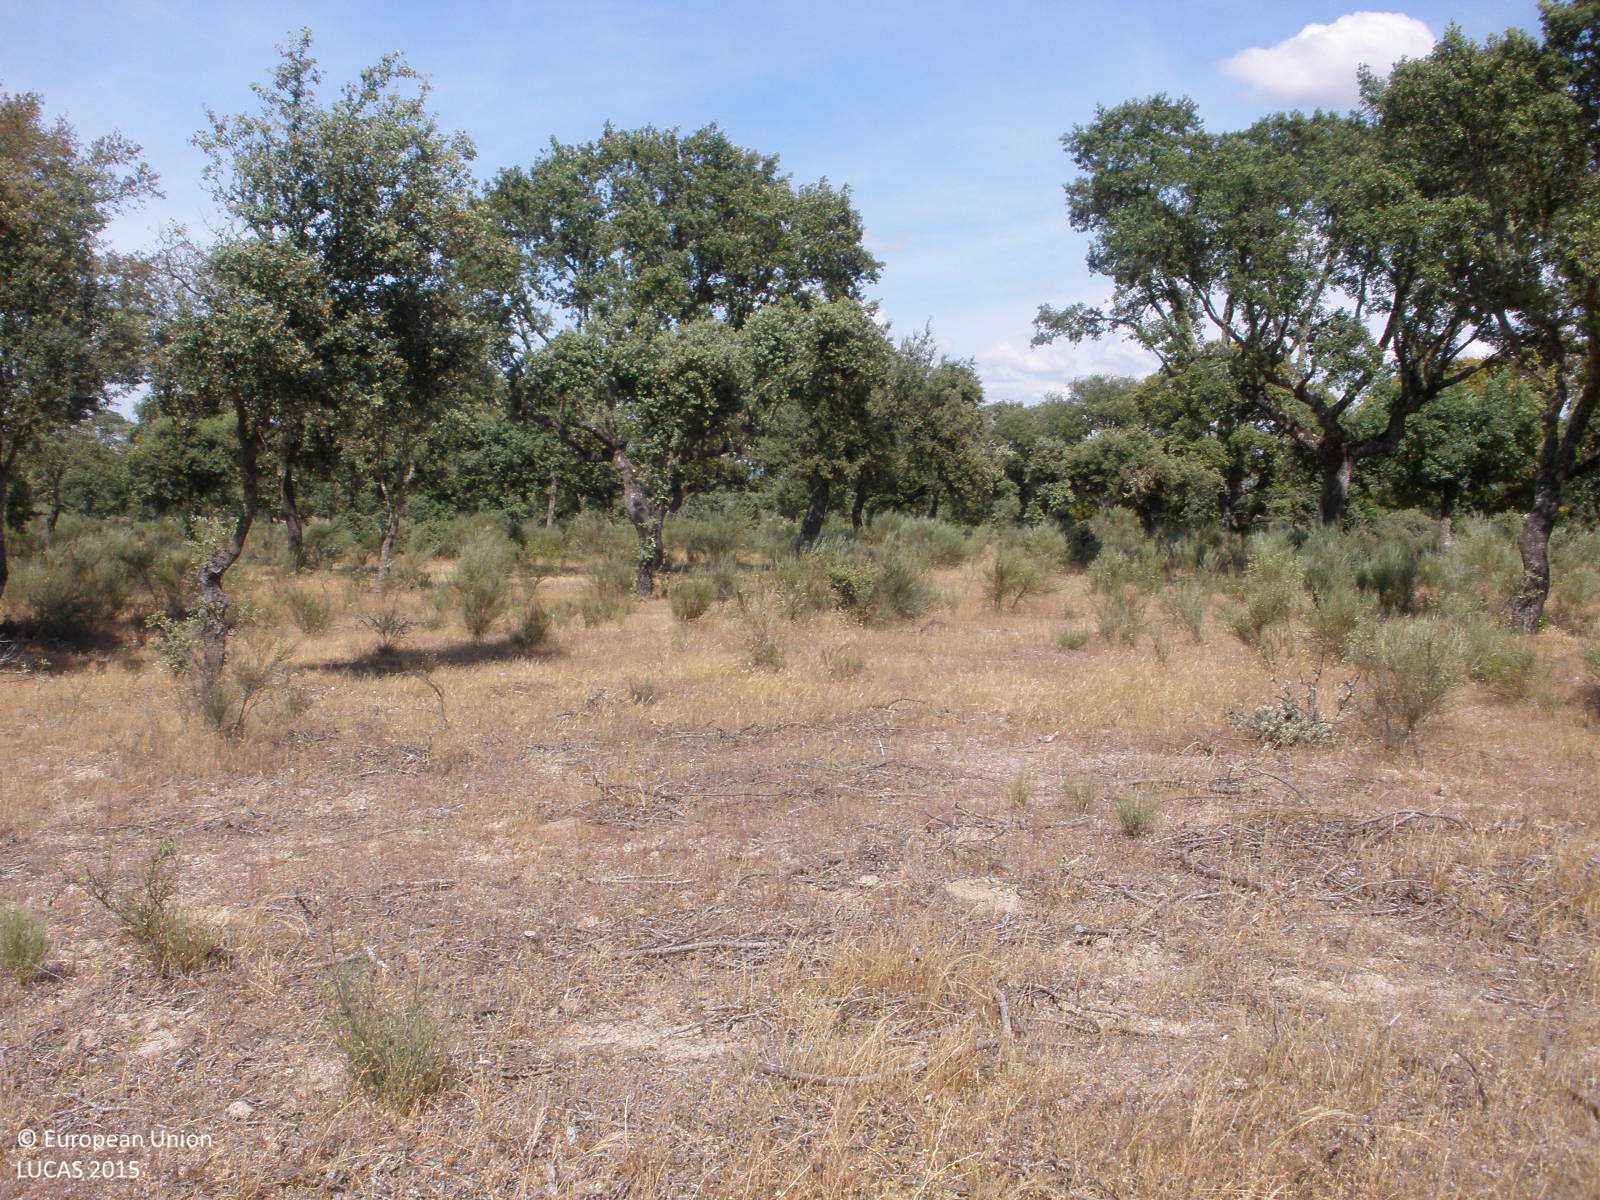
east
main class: Woodland
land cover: Broadleaved woodland
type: broadleaved evergreen forest
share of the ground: 50 - 75 %
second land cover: Grassland without tree/shrub cover
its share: > 75 %
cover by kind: broadleaved forest trees 50 %, herbaceous plants 40 %, shrubs 10 %
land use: Forestry
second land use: Agriculture (excluding fallow land and kitchen gardens)
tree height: > 5 m
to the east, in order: Broadleaved woodland; Grassland without tree/shrub cover; Grassland with sparse tree/shrub cover; Broadleaved woodland
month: June
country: ES
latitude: 40.5685
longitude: -6.7367
